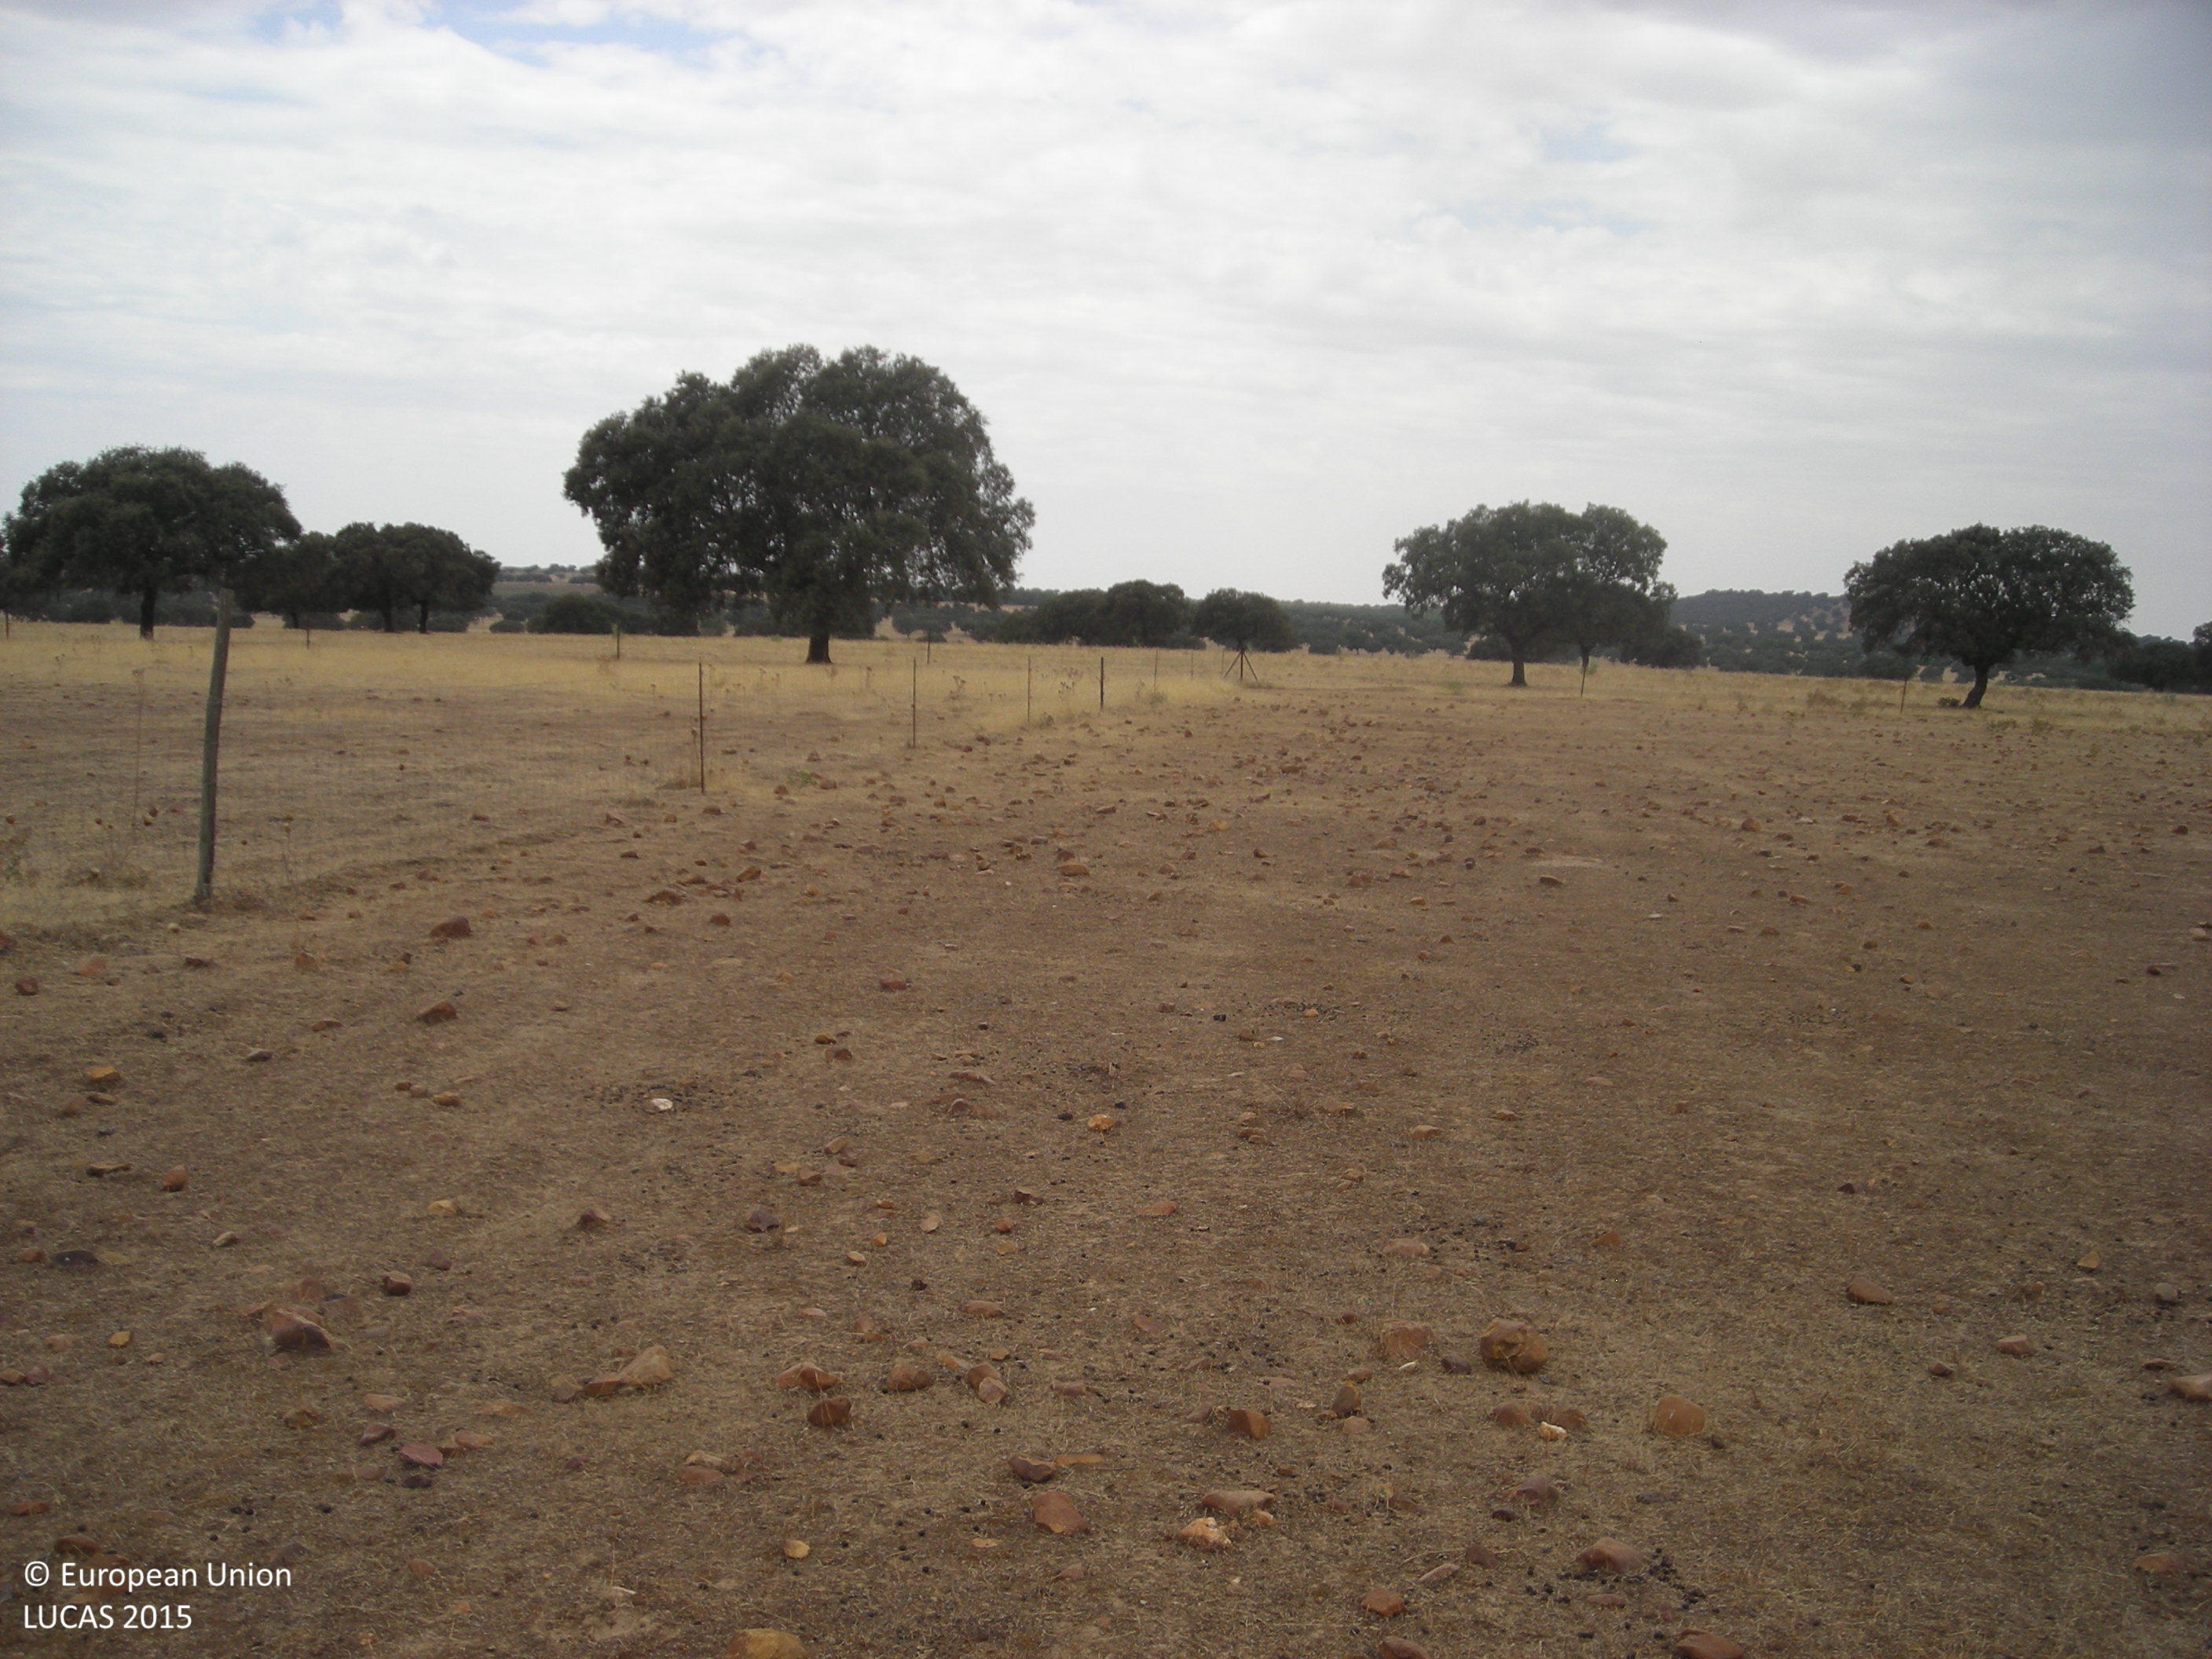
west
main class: Grassland
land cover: Grassland without tree/shrub cover
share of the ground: > 75 %
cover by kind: herbaceous plants 100 %
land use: Agriculture (excluding fallow land and kitchen gardens)
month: July
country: ES
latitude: 39.1743
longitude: -5.4994
